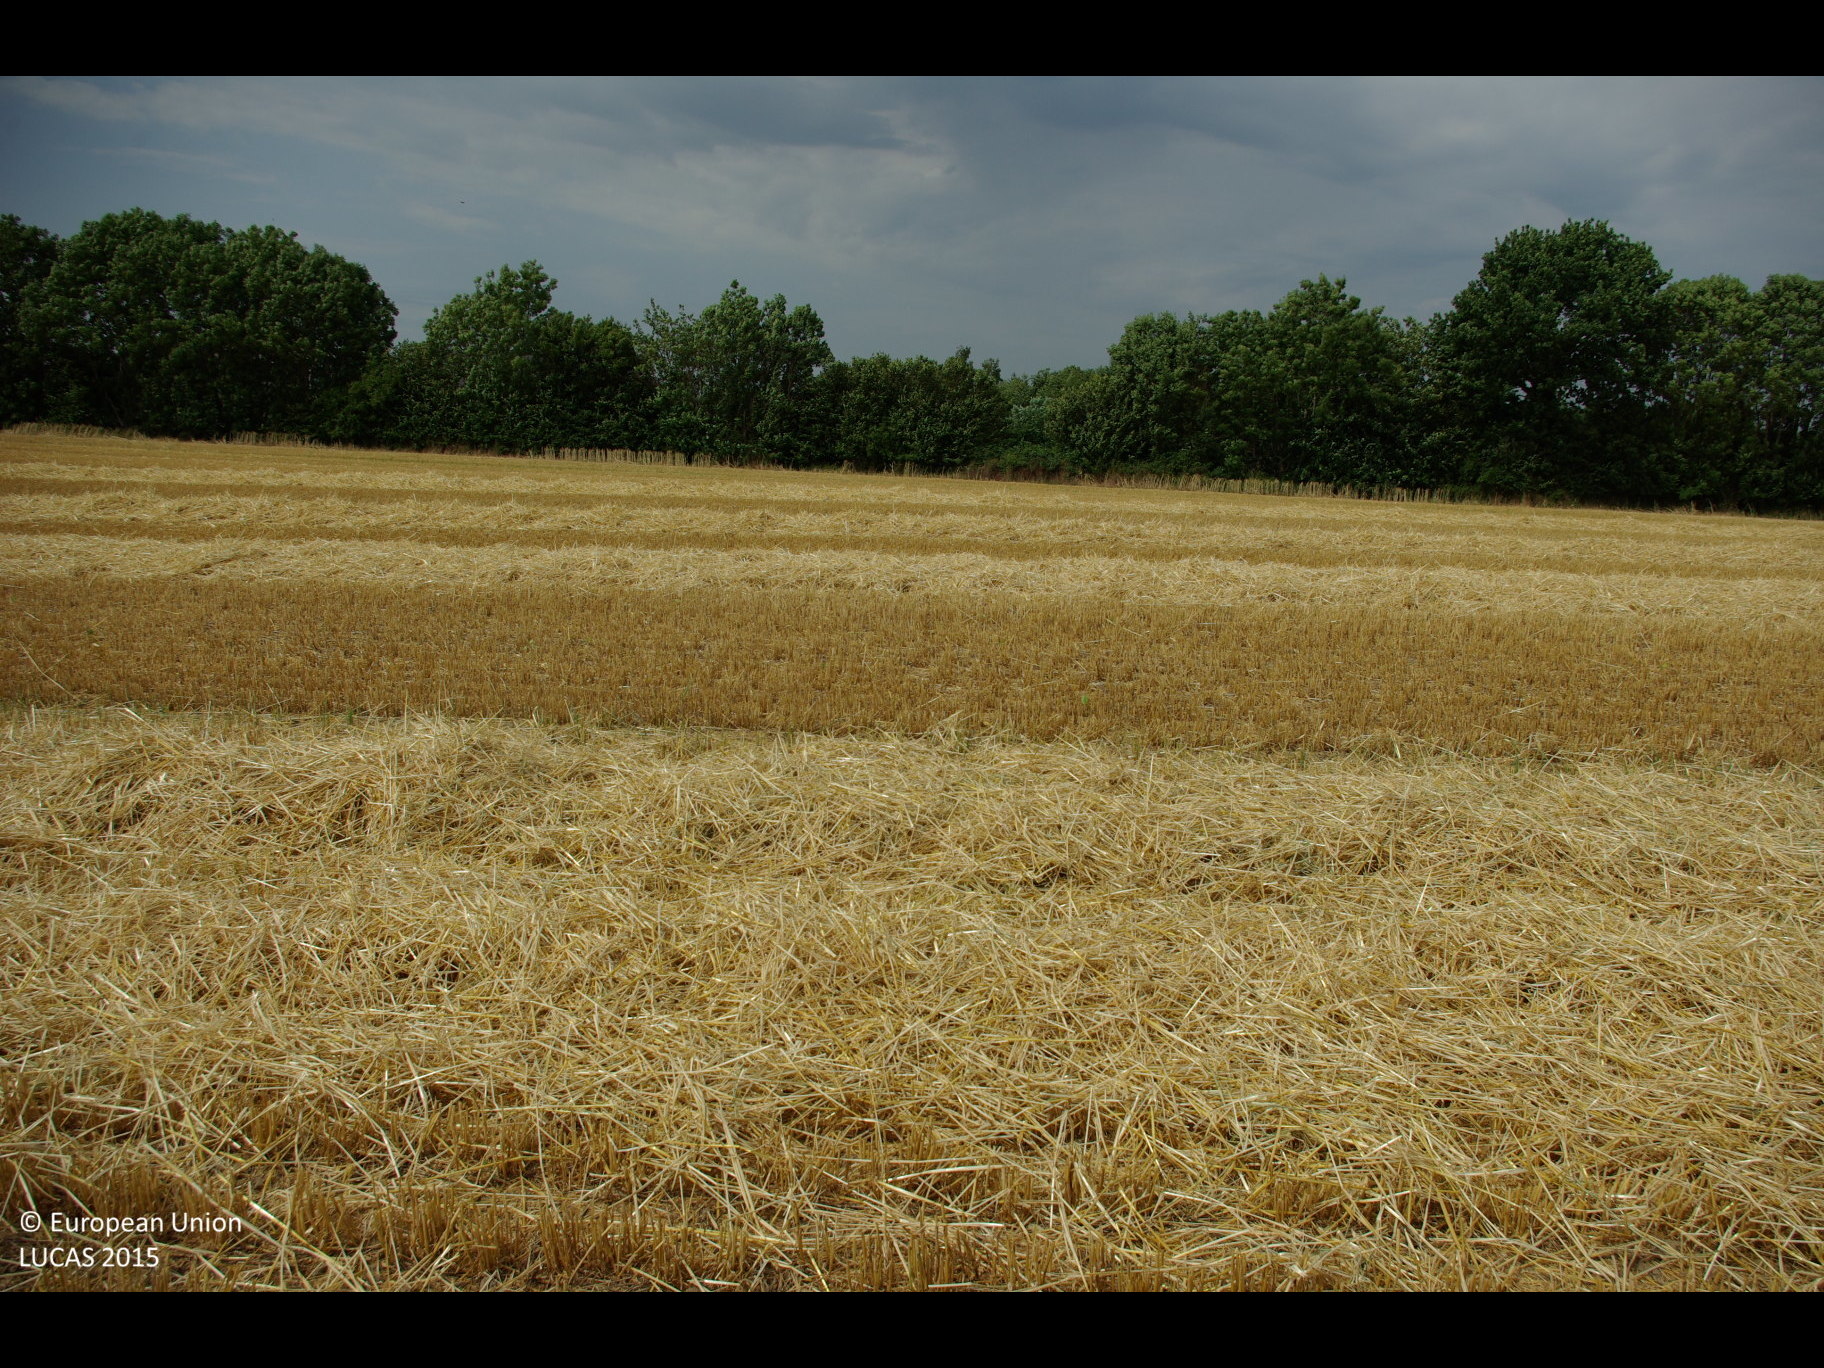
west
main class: Cropland
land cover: Barley
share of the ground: < 10 %
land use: Agriculture (excluding fallow land and kitchen gardens)
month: July
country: DE
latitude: 54.7497
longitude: 9.8603
